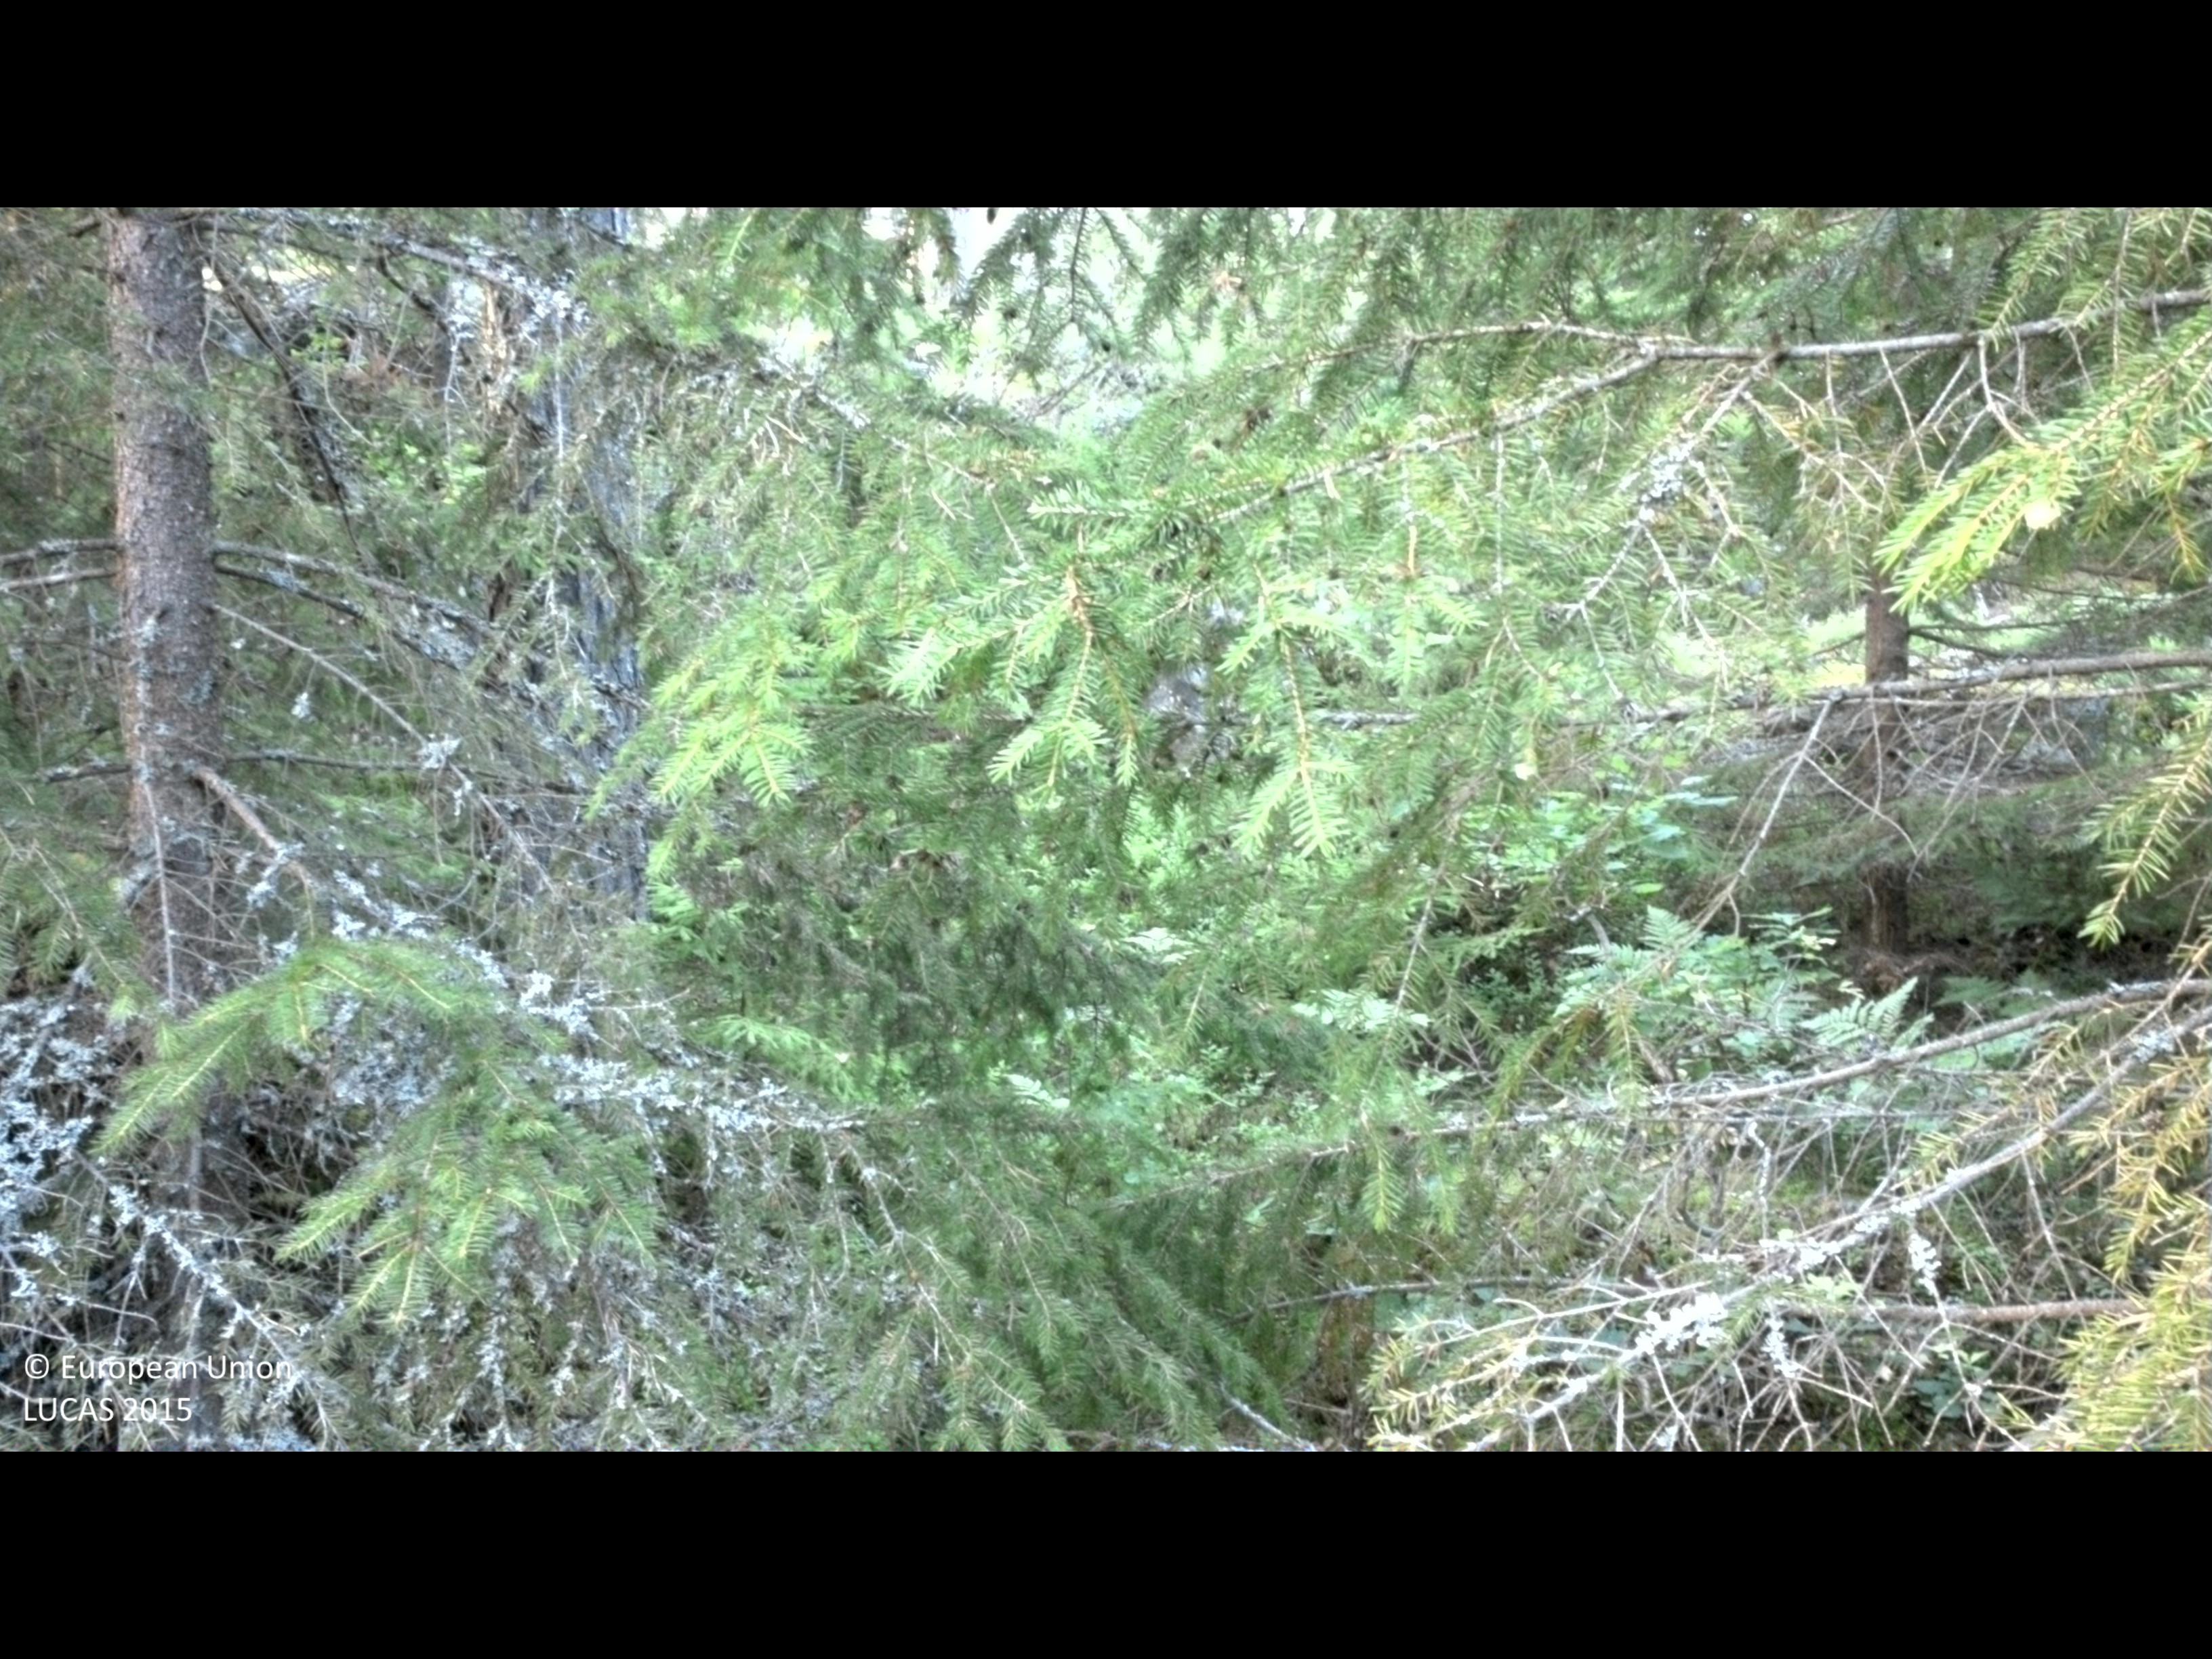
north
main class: Woodland
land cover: Spruce dominated coniferous woodland
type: boreal forest
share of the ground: 50 - 75 %
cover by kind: coniferous forest trees 55 %, shrubs 35 %, broadleaved forest trees 5 %, herbaceous plants 5 %
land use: Forestry
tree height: > 5 m
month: July
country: SE
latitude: 58.0740
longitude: 16.2529
